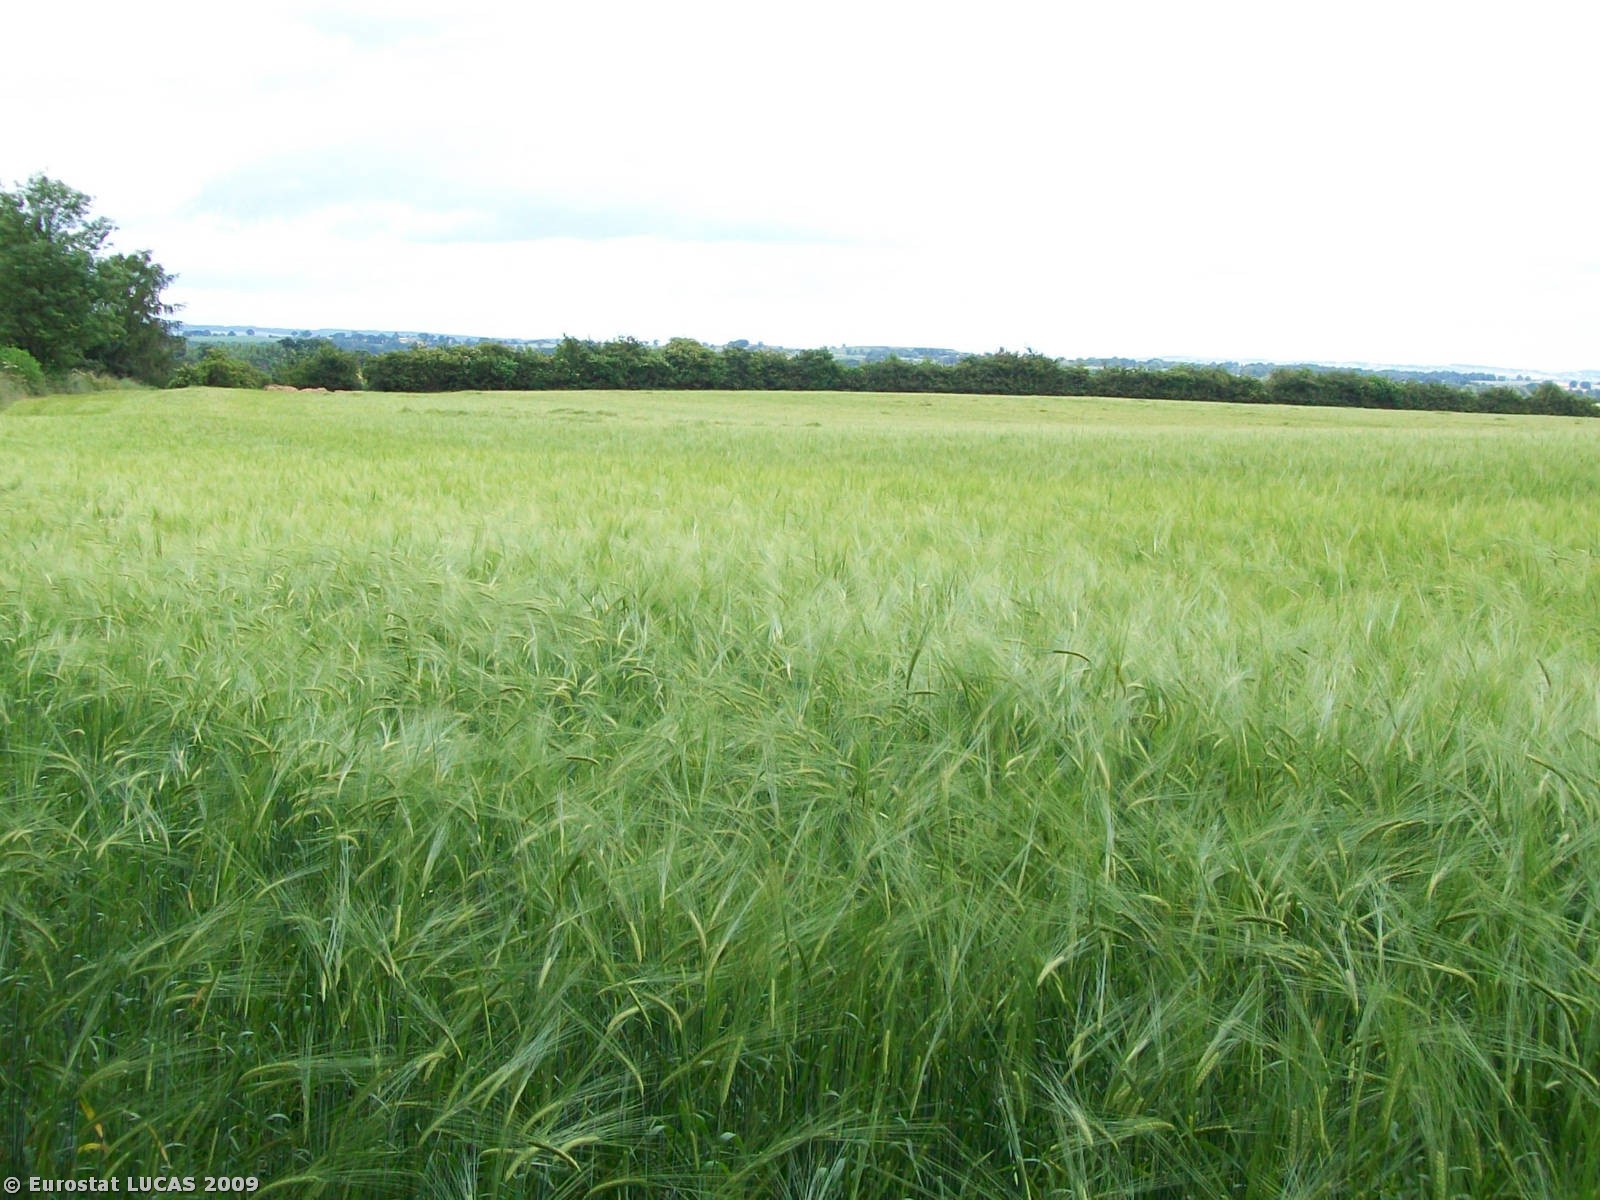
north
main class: Cropland
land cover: Barley
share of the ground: > 75 %
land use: Agriculture (excluding fallow land and kitchen gardens)
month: July
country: GB
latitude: 54.5069
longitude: -1.8684
